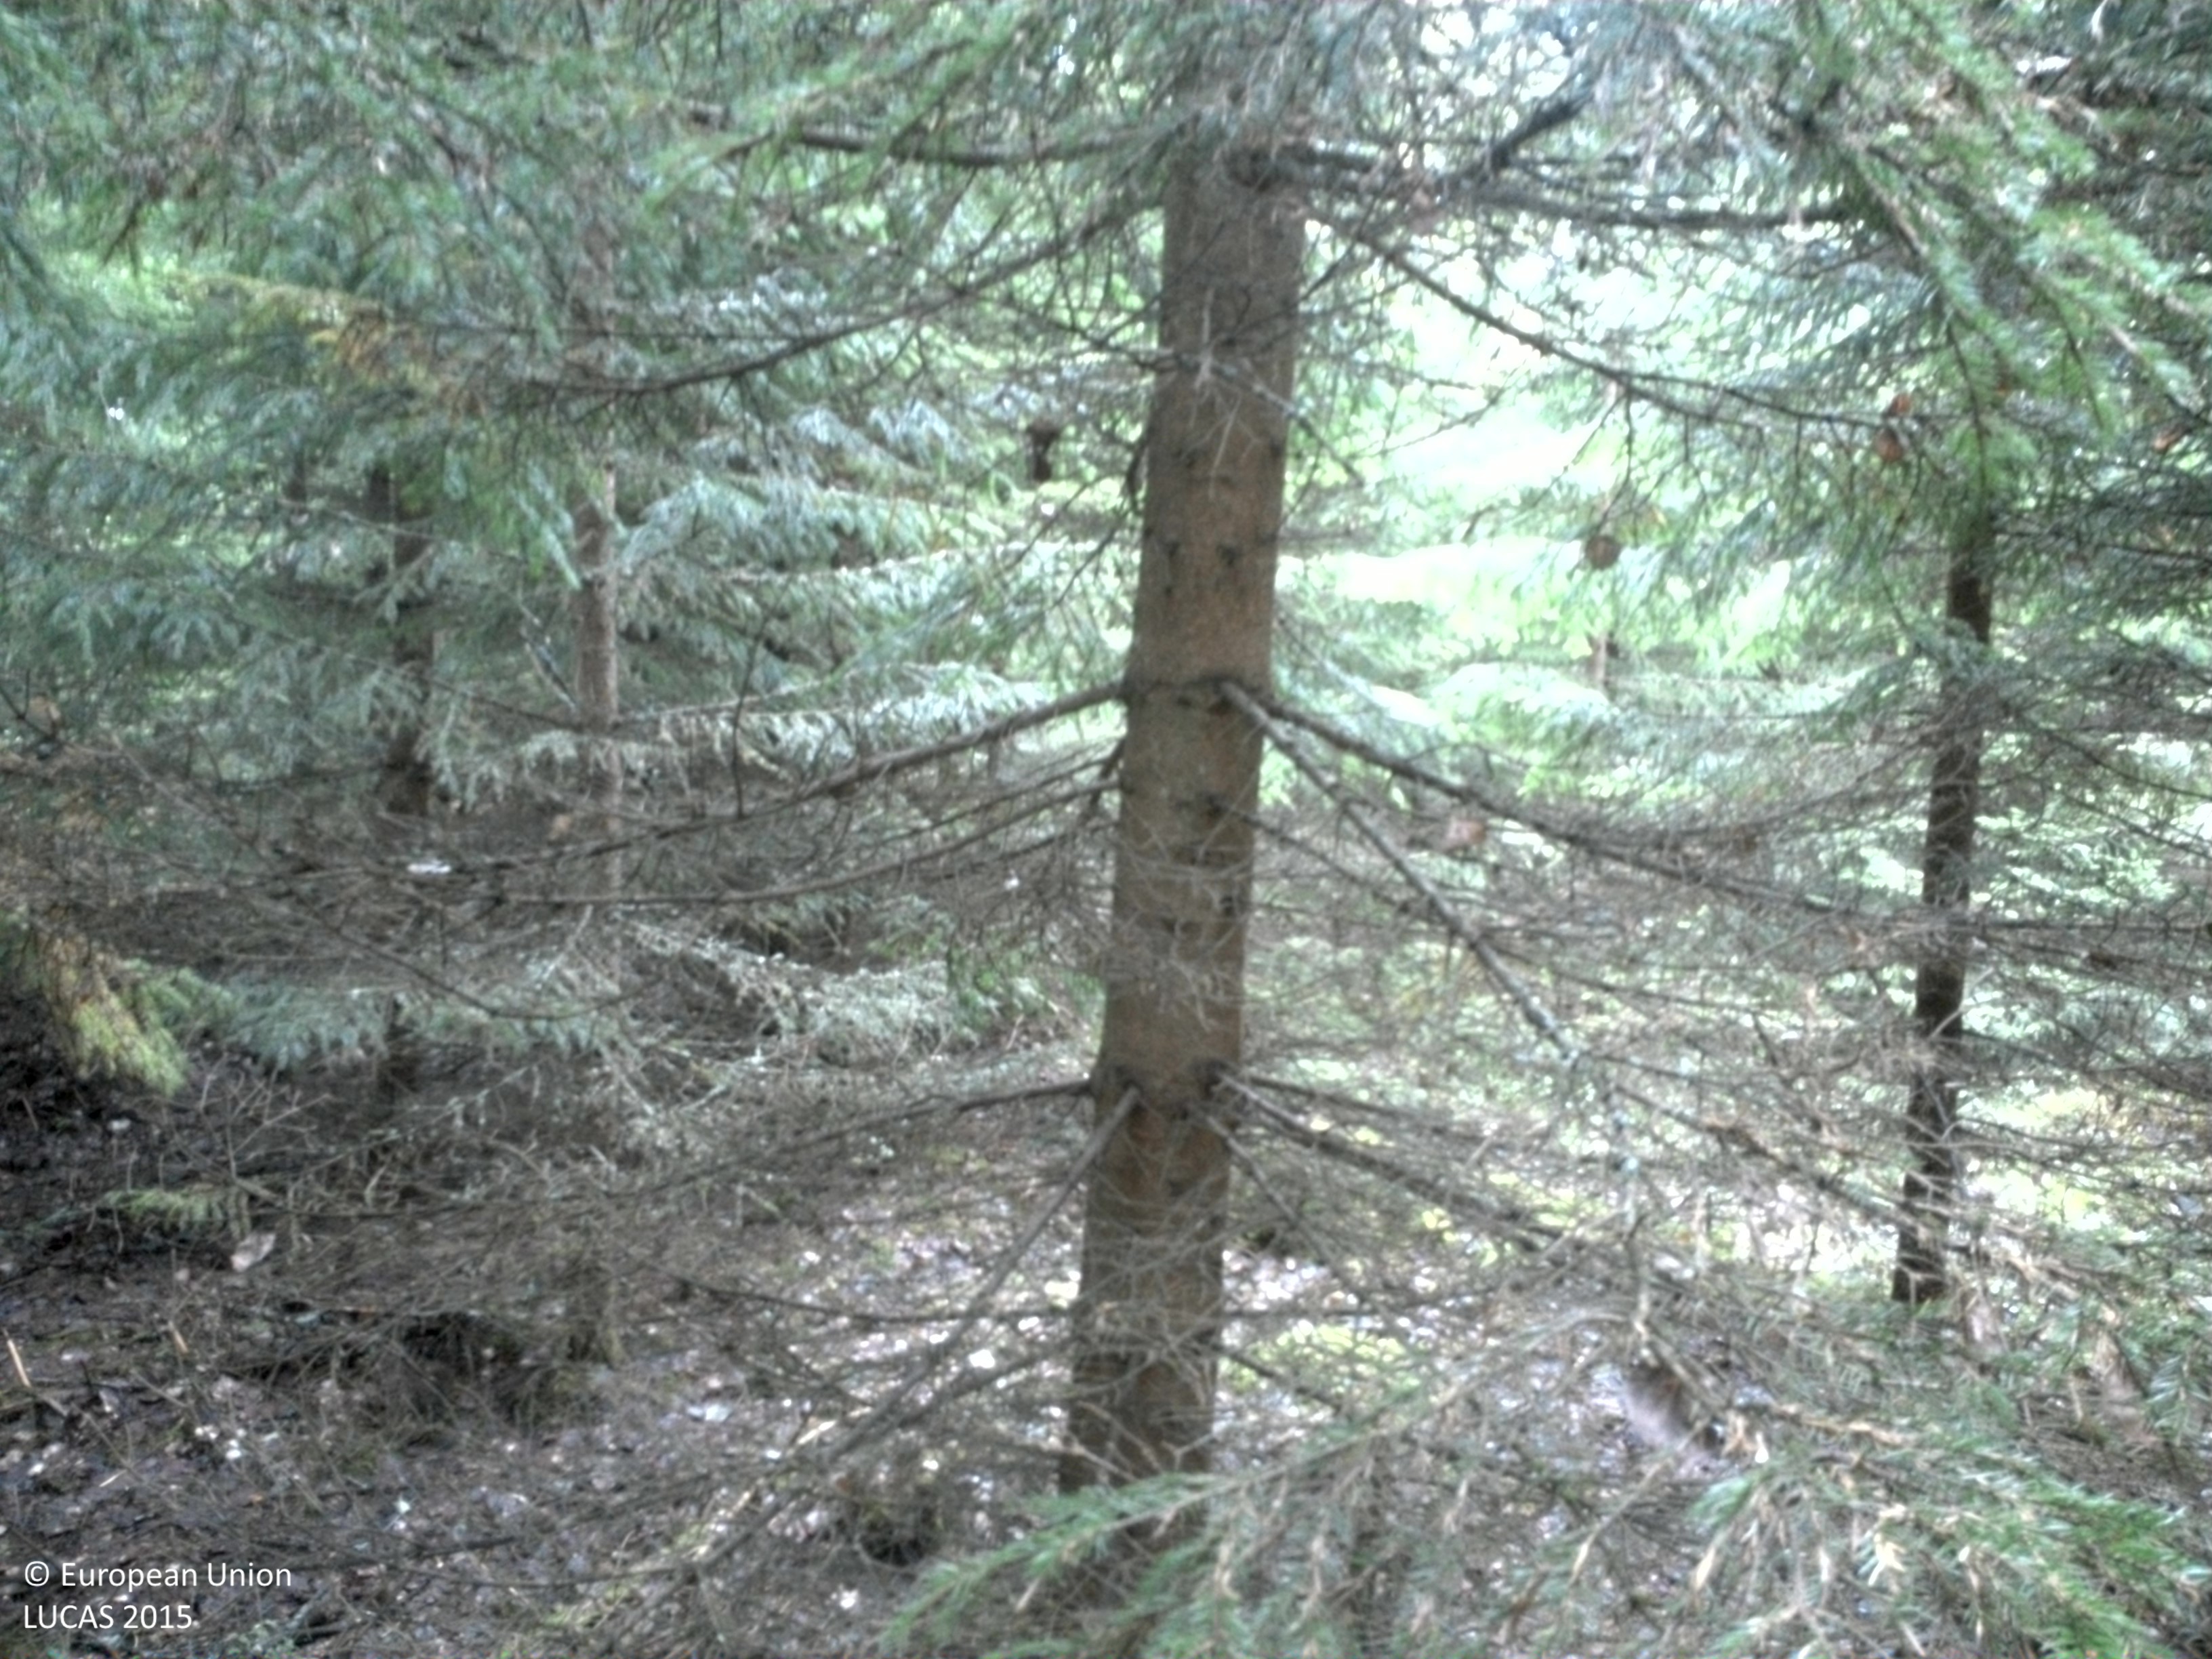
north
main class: Woodland
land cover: Spruce dominated coniferous woodland
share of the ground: > 75 %
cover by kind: coniferous forest trees 80 %, broadleaved forest trees 10 %, lichens and mosses 10 %
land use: Forestry
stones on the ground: < 10 %
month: August
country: SE
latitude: 57.8732
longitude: 13.9568
